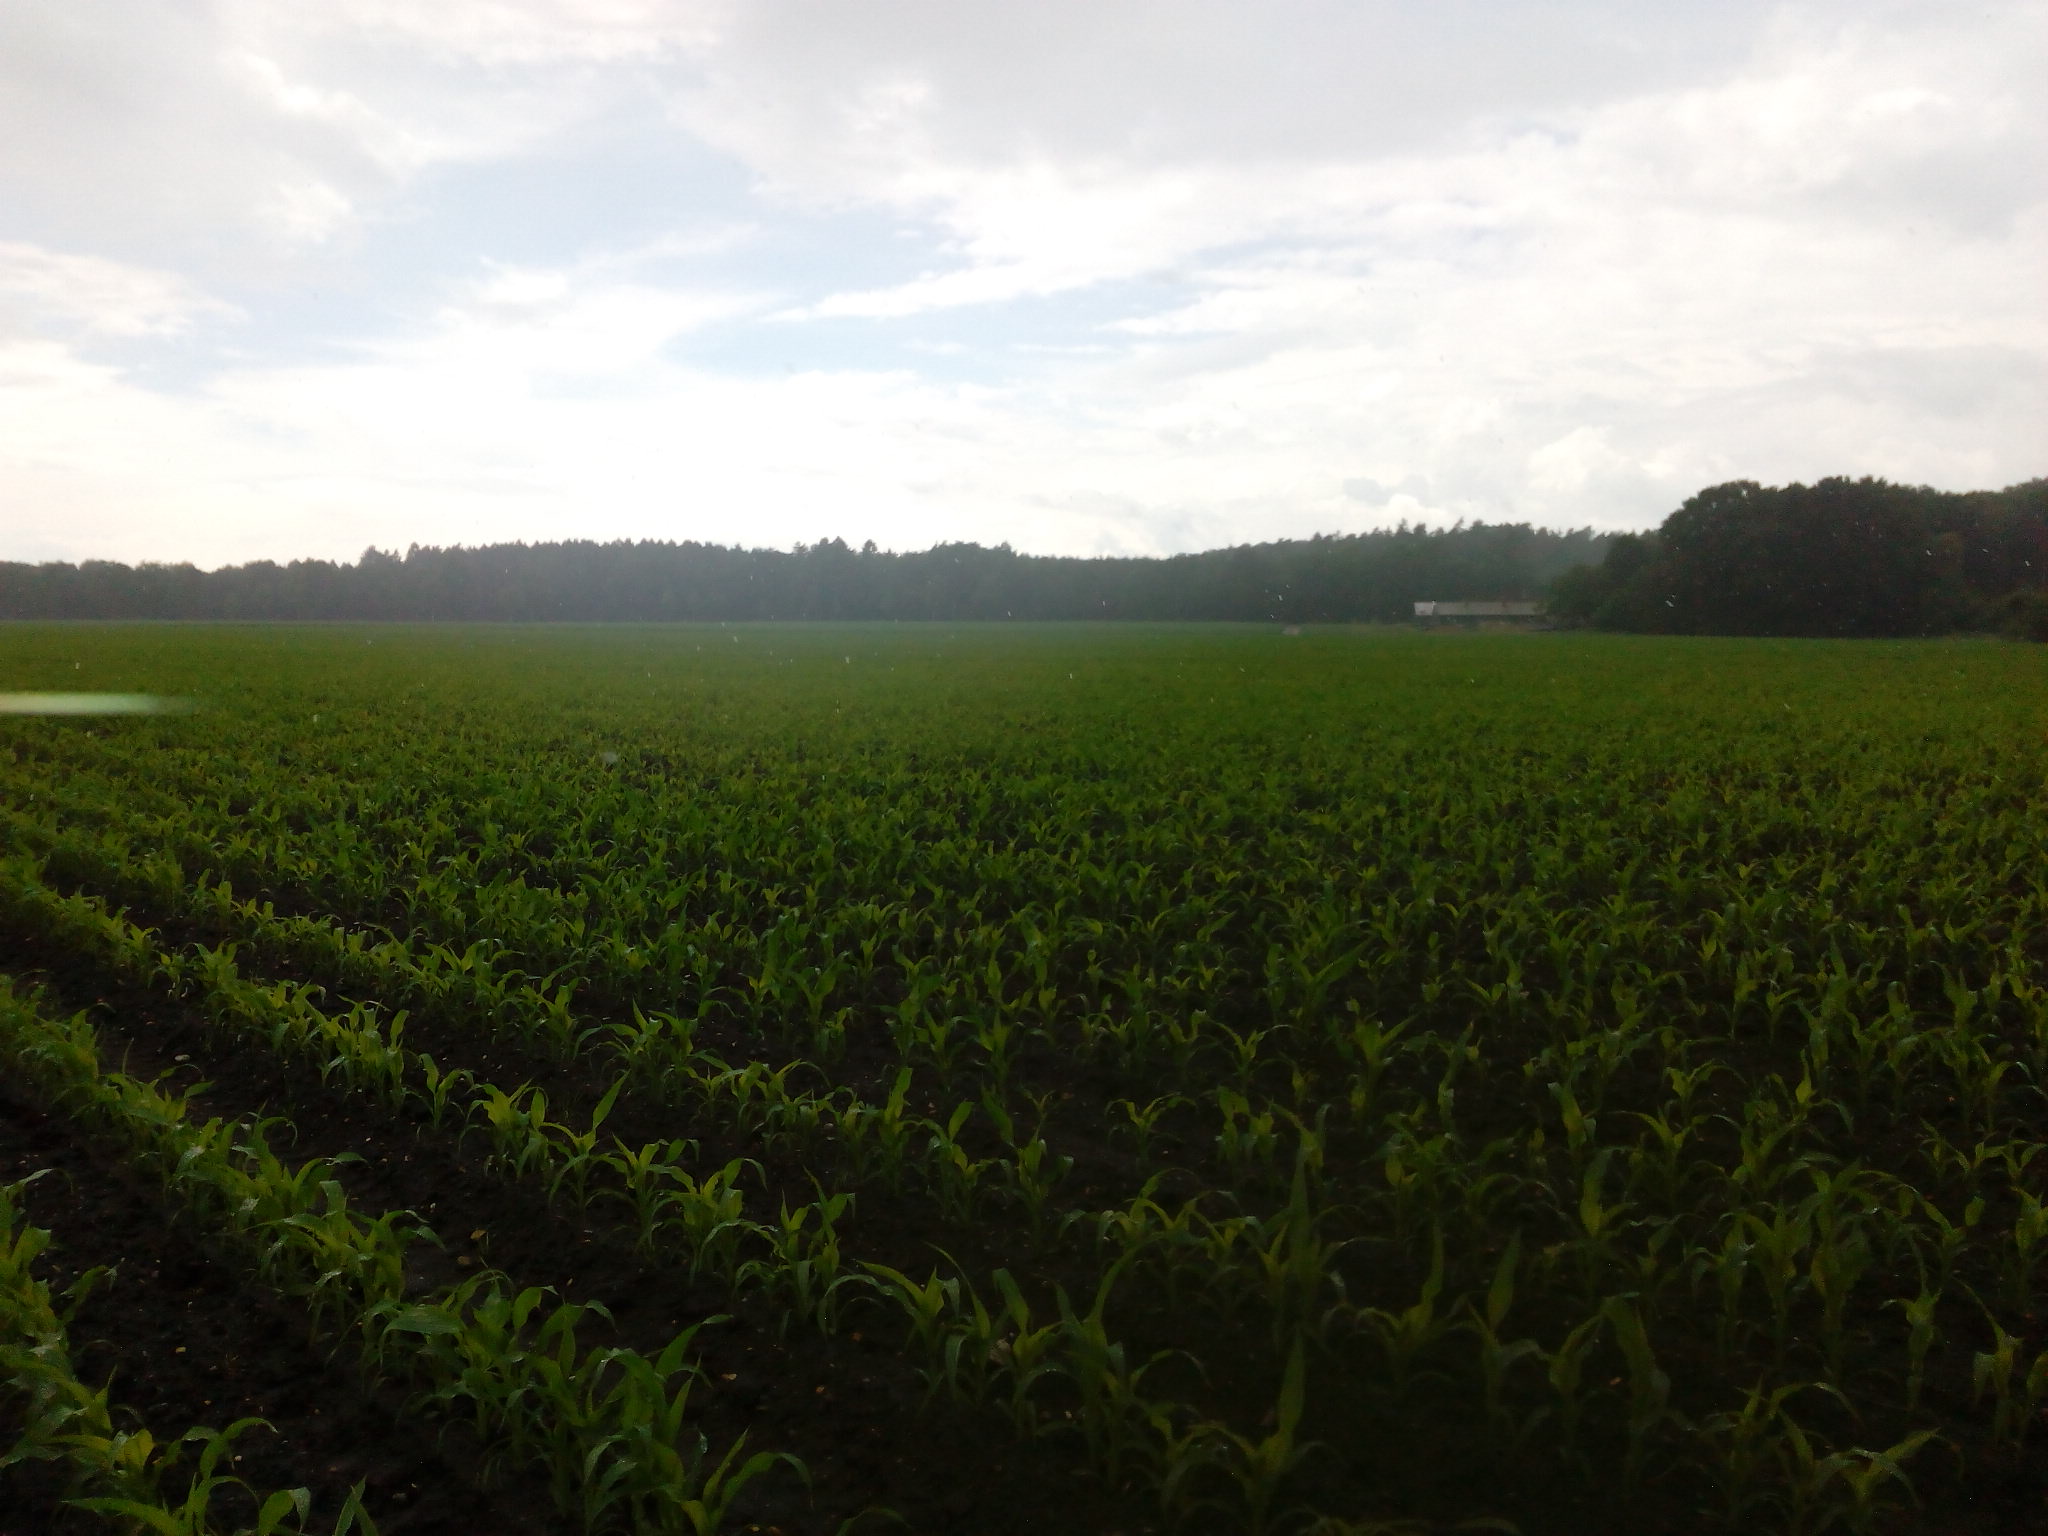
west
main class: Cropland
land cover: Maize
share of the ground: 50 - 75 %
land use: Agriculture (excluding fallow land and kitchen gardens)
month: June
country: DE
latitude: 52.8987
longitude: 9.9257
